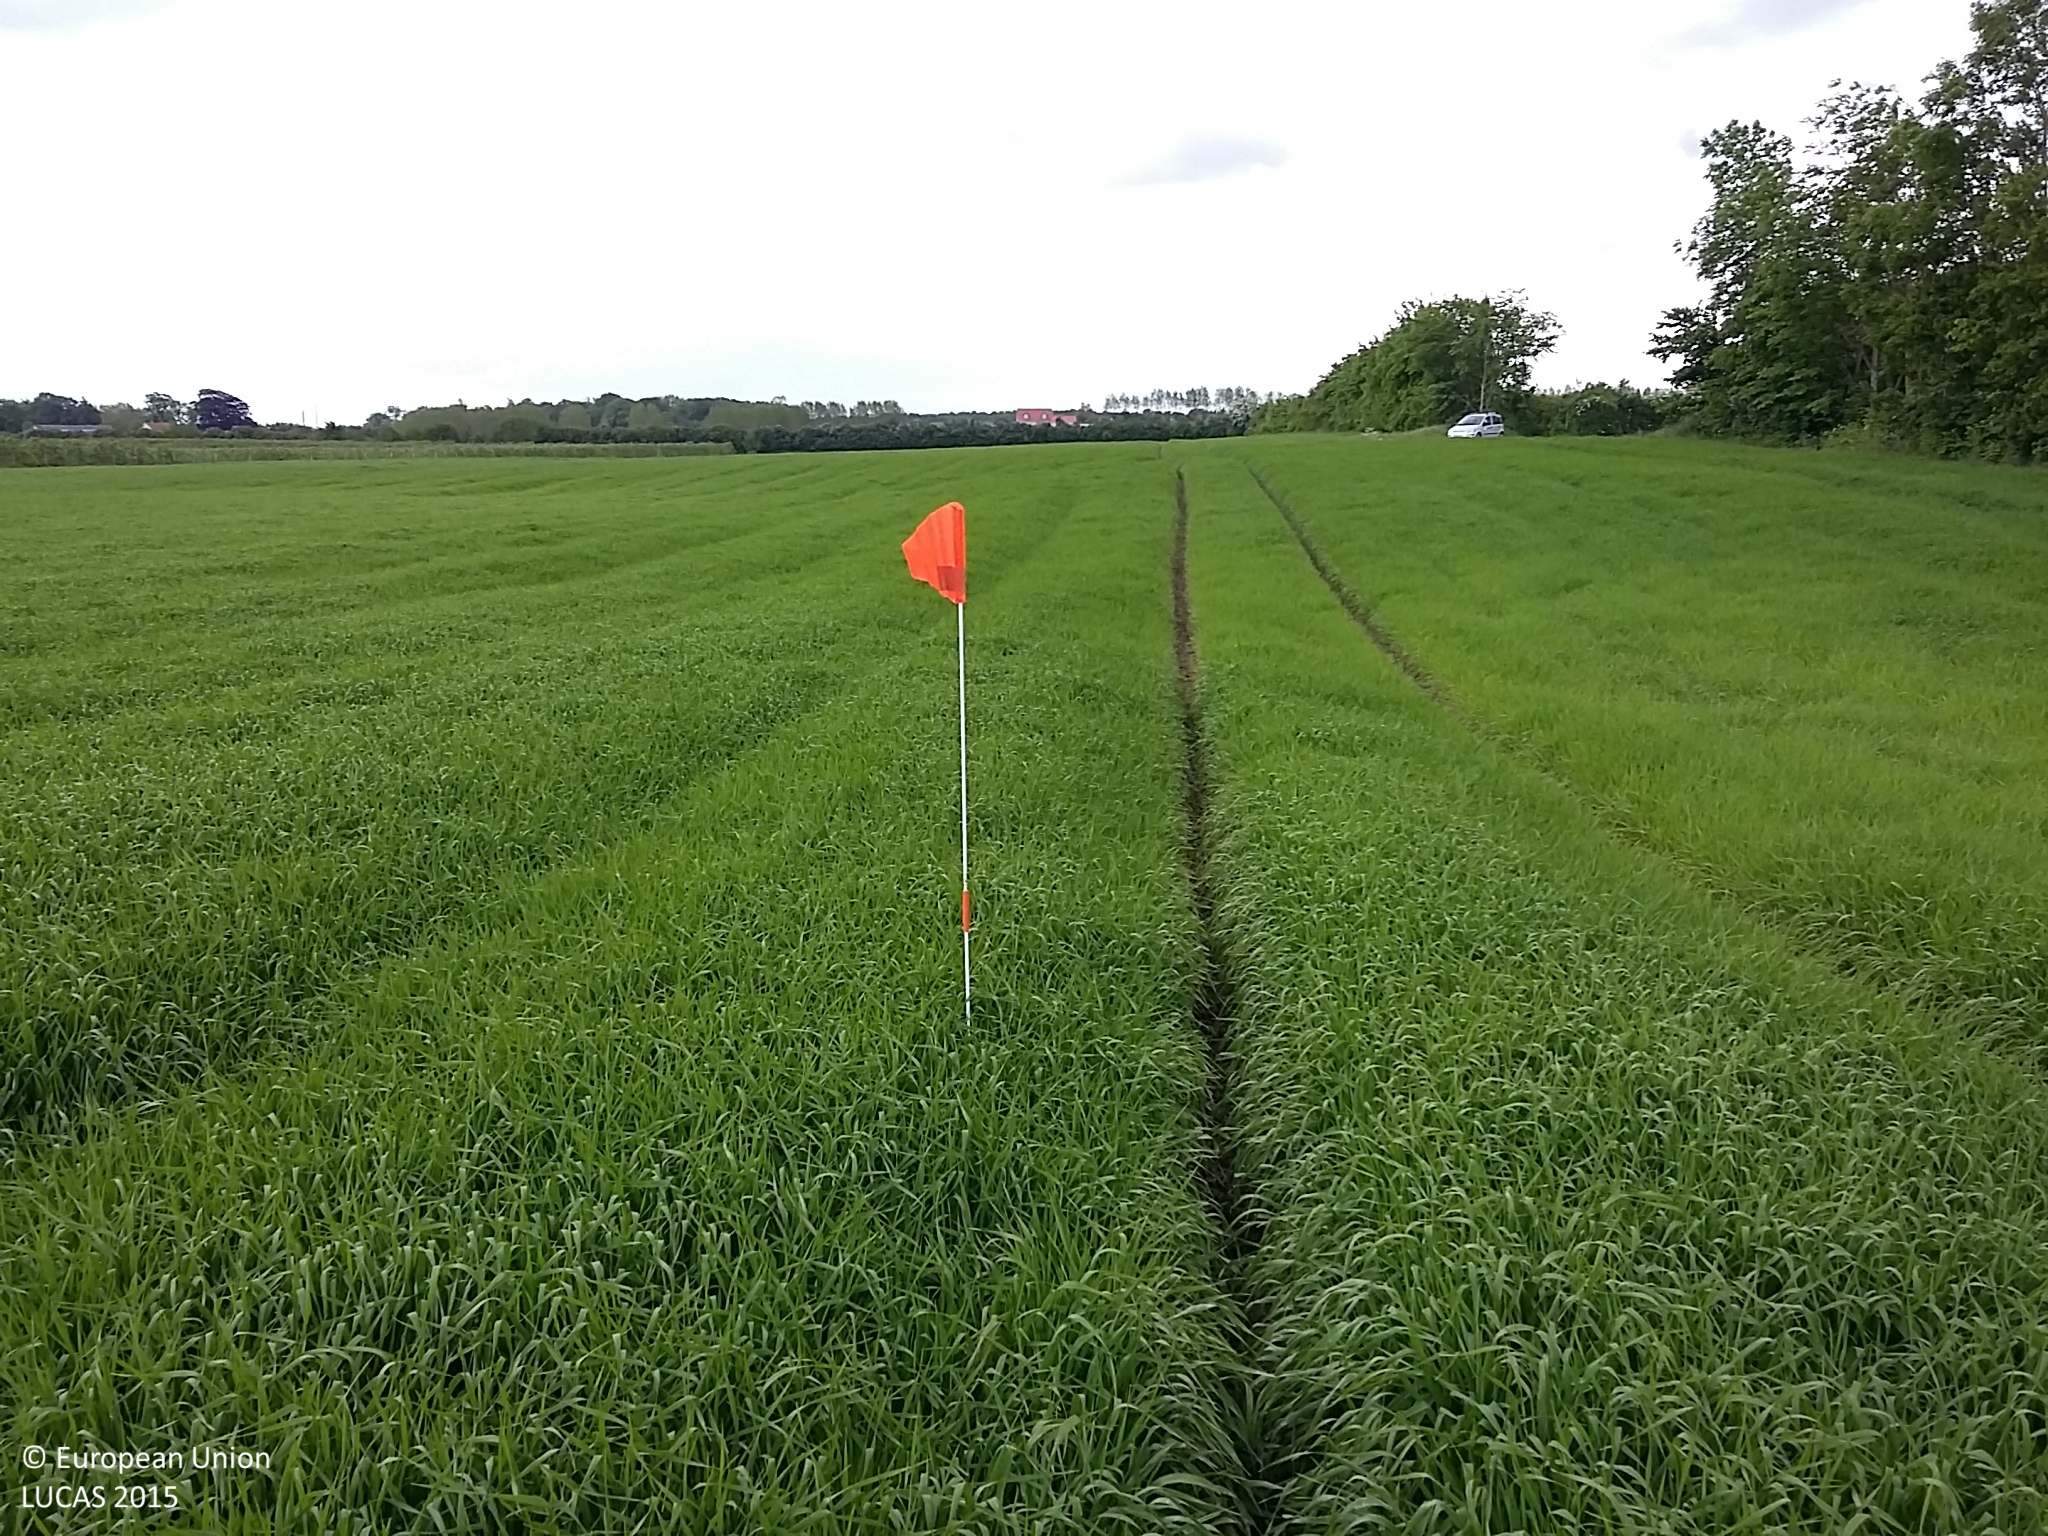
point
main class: Cropland
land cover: Barley
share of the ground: > 75 %
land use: Agriculture (excluding fallow land and kitchen gardens)
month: June
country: DK
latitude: 55.3586
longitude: 10.7722
